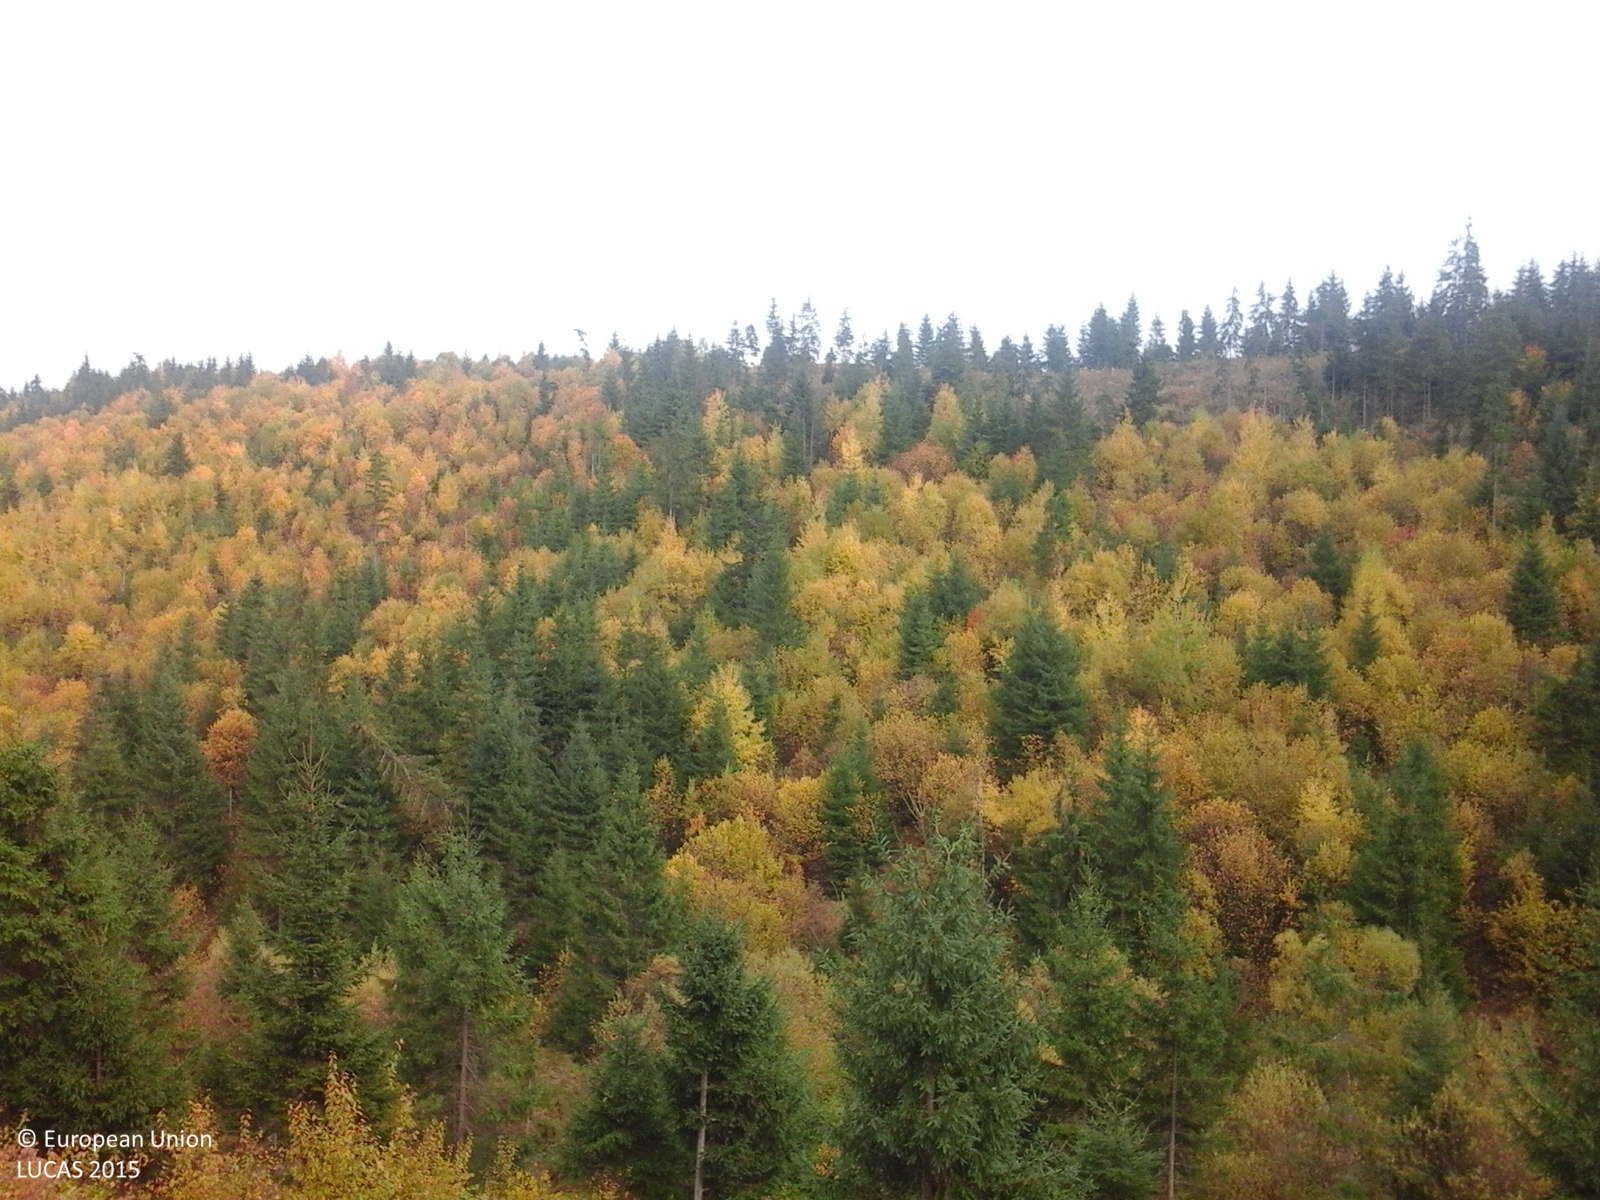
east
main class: Woodland
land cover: Spruce dominated coniferous woodland
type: alpine coniferous forest
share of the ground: 10 - 25 %
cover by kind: coniferous forest trees 100 %
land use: Forestry
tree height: > 5 m
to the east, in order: Spruce dominated coniferous woodland; Ditches and canals; Shruby margins; Tracks; Shruby margins; Abandoned hedges; Inland fresh running water; Abandoned hedges; Spruce dominated coniferous woodland
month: October
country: RO
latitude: 46.9271
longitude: 25.3026
